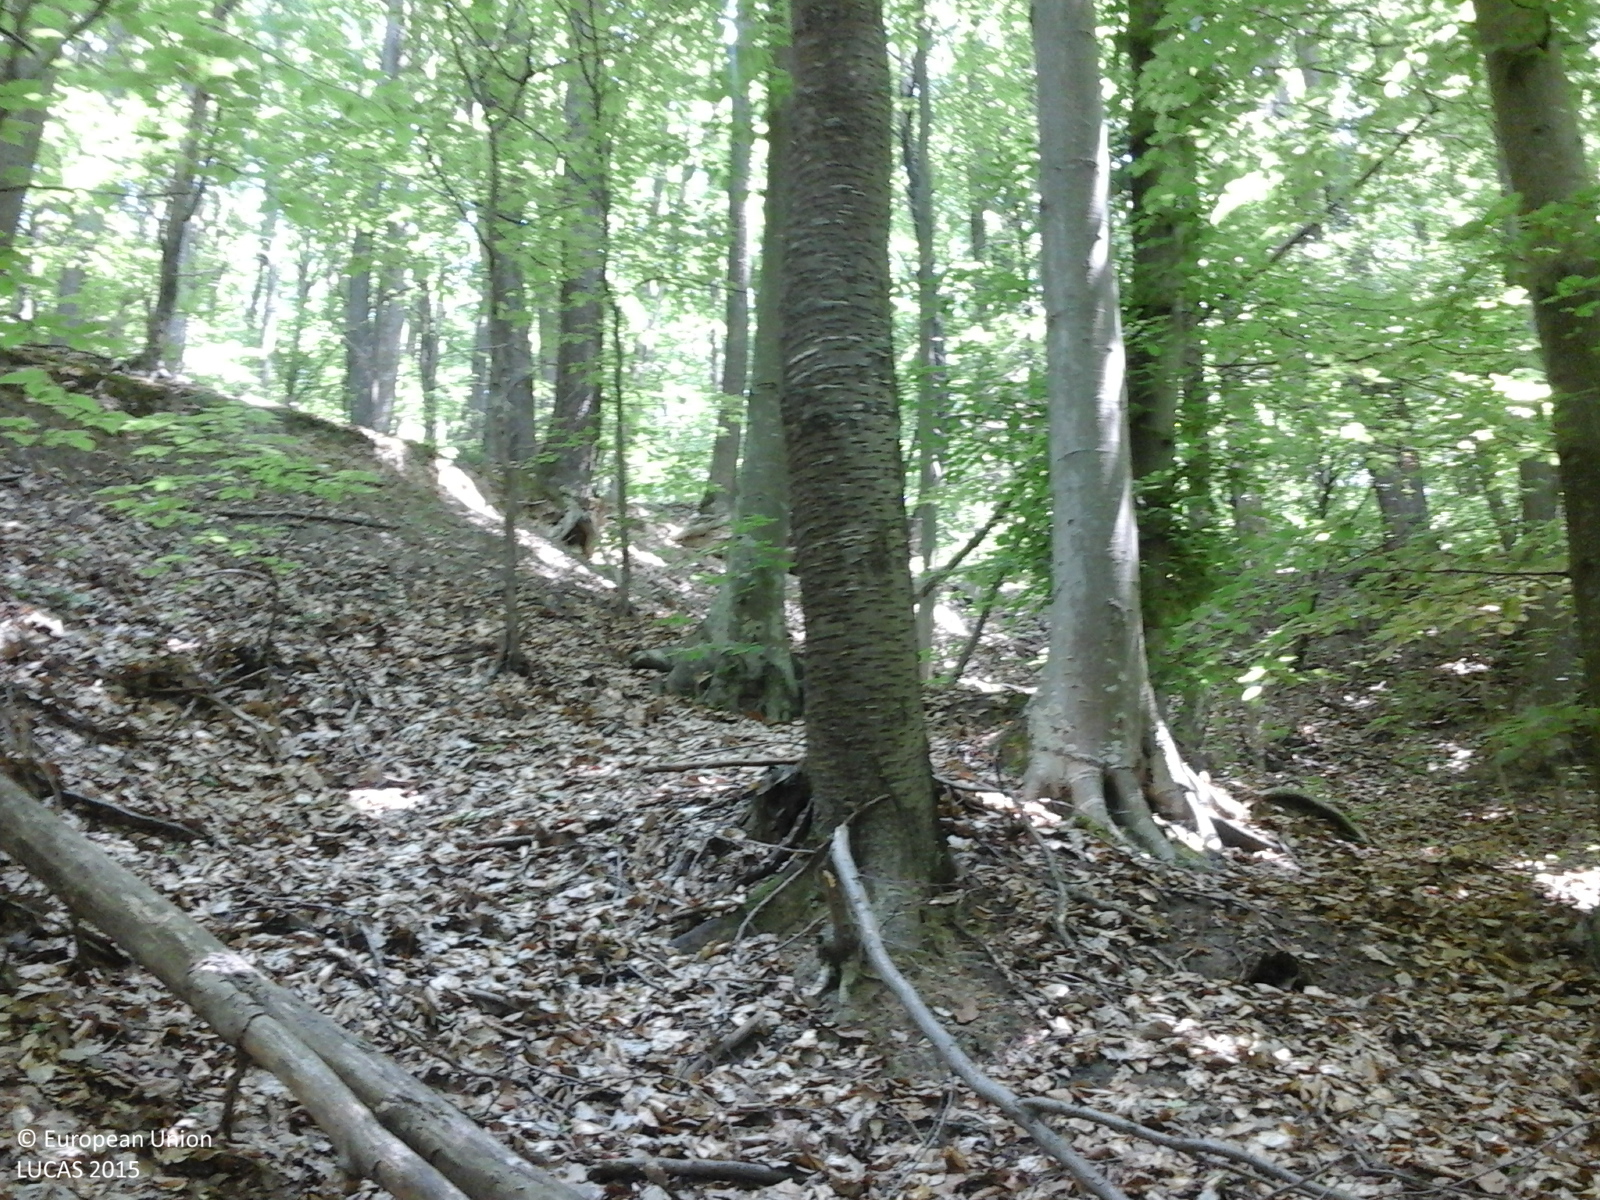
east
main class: Woodland
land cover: Broadleaved woodland
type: beech forest
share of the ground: > 75 %
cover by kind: broadleaved forest trees 100 %
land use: Forestry
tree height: > 5 m
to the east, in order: Broadleaved woodland; Tracks; Broadleaved woodland
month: June
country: RO
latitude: 46.6015
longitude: 26.7337
